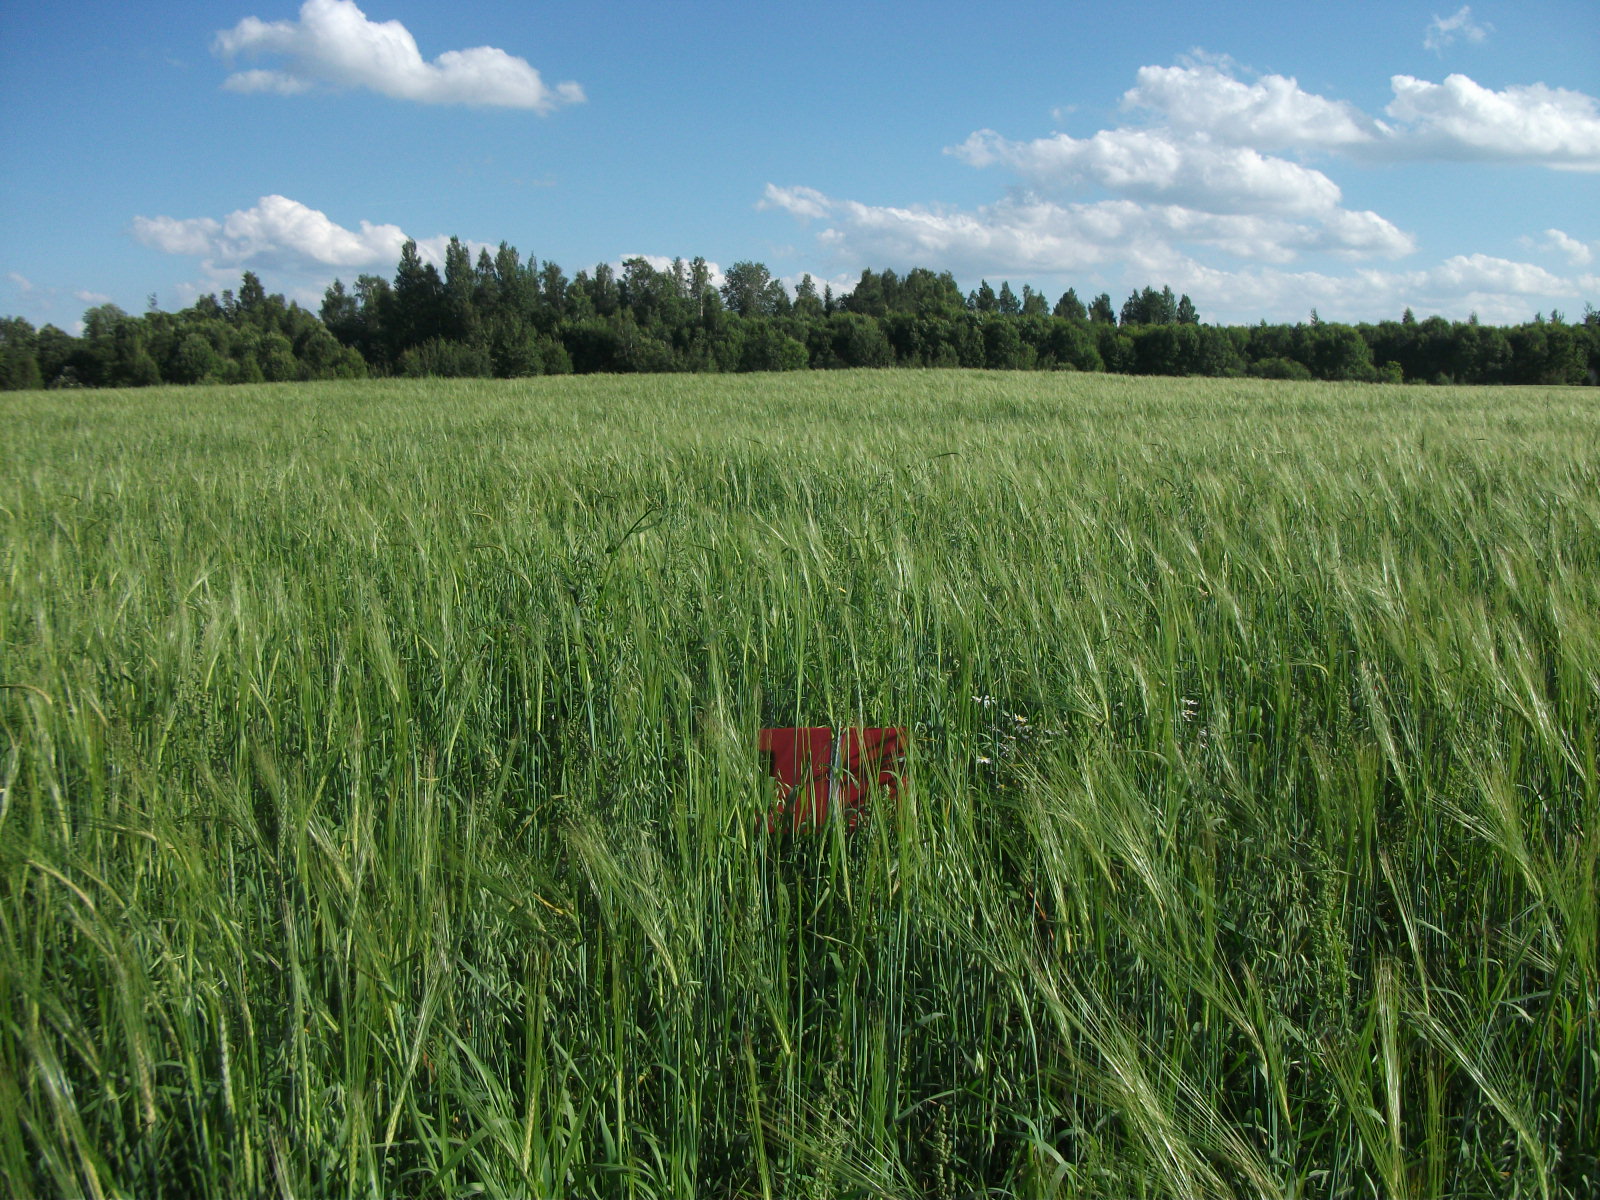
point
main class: Cropland
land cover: Barley
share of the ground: > 75 %
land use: Agriculture (excluding fallow land and kitchen gardens)
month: August
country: LV
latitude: 57.0449
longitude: 26.6146
